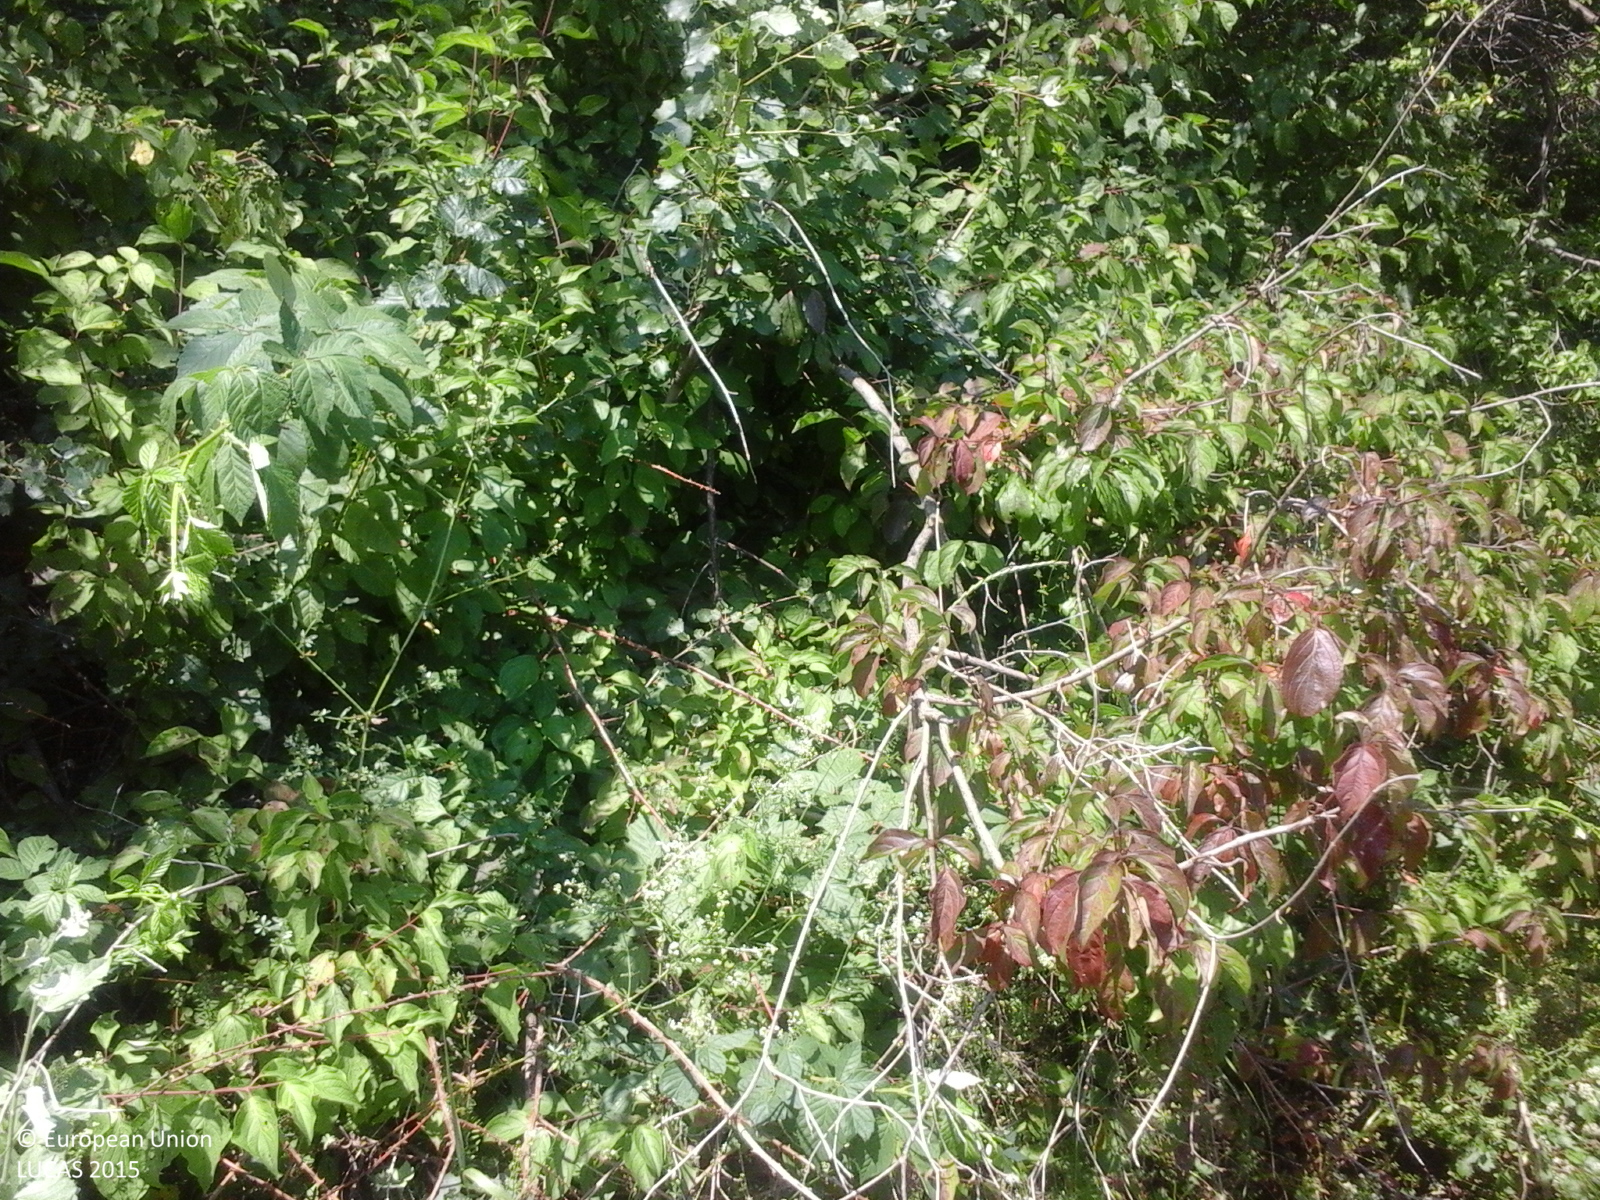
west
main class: Woodland
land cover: Broadleaved woodland
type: non-riverine alder, birch or aspen forest
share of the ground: > 75 %
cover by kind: broadleaved forest trees 100 %
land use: Forestry
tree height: > 5 m
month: July
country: RO
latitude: 44.8045
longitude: 24.5251
